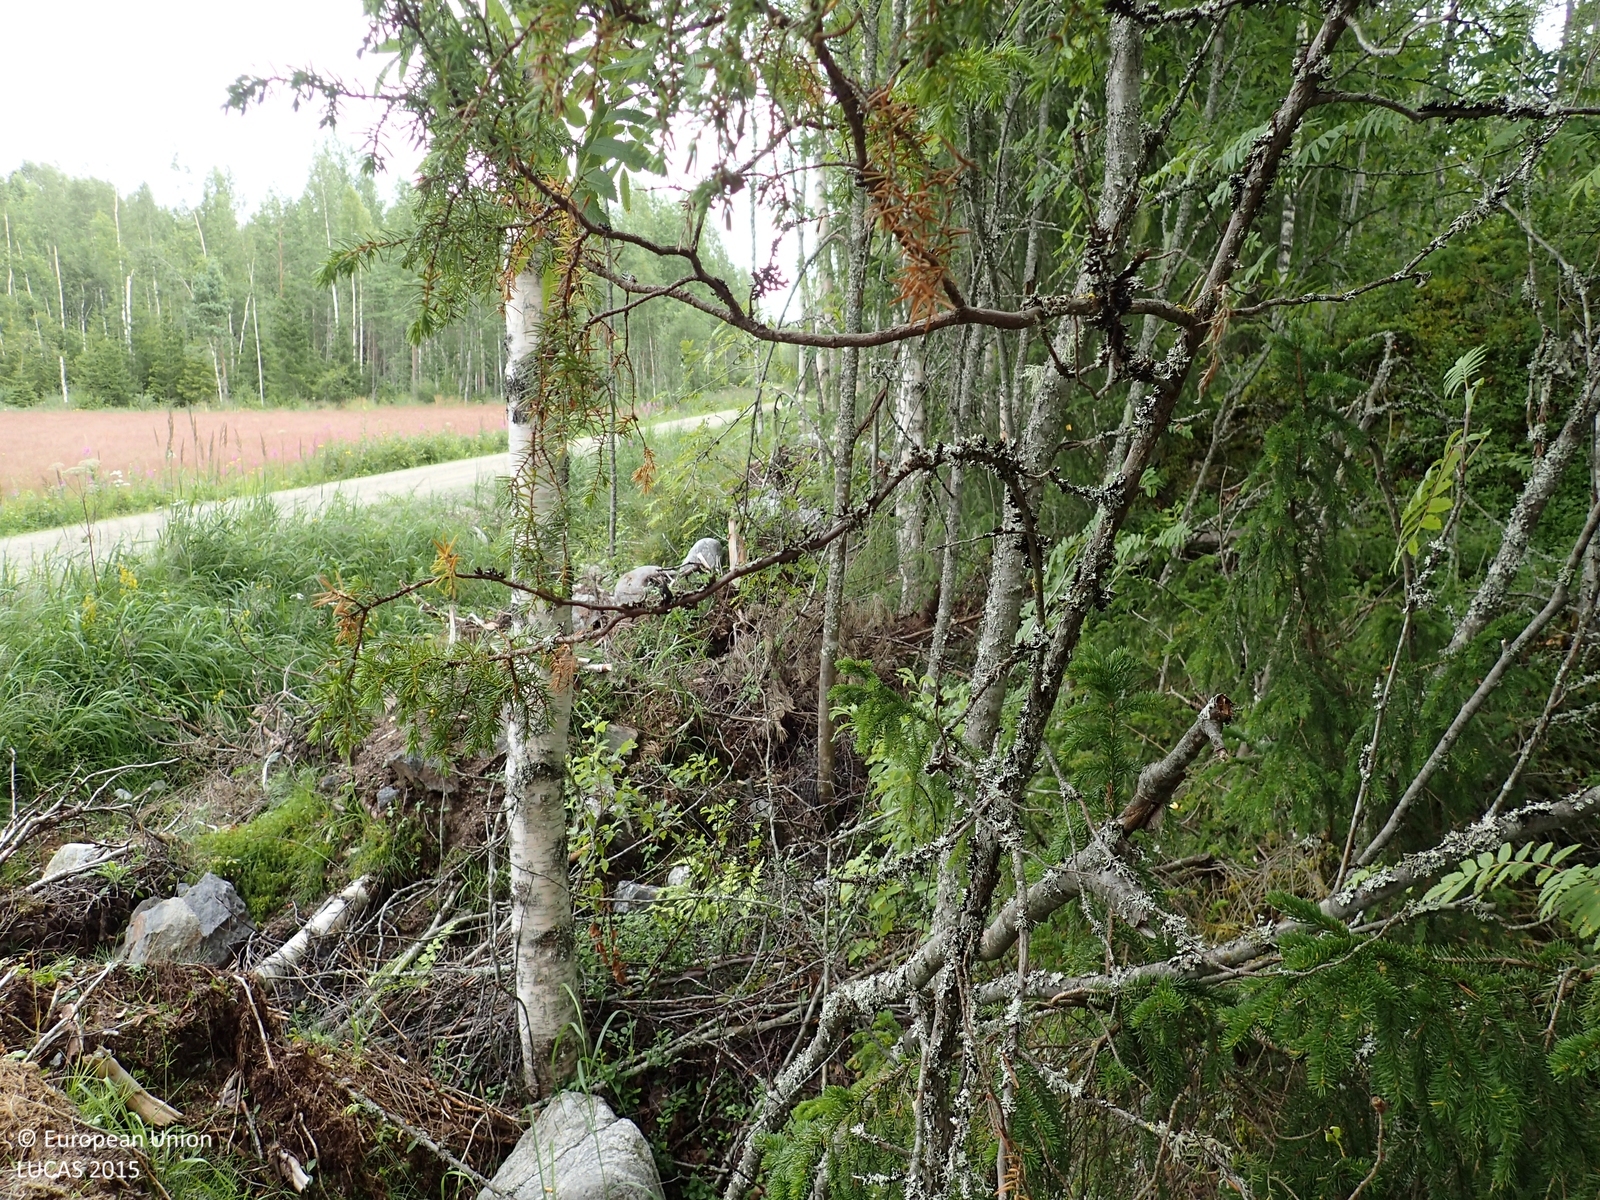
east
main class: Woodland
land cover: Other mixed woodland
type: boreal forest
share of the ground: > 75 %
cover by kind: coniferous forest trees 55 %, broadleaved forest trees 20 %, shrubs 20 %, lichens and mosses 5 %
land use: Forestry
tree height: > 5 m
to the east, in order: Other mixed woodland; Ditches and canals; Grass margins; Paved roads, cycling and walking lanes; Grass margins; Ditches and canals; Spontaneously vegetated surfaces; Pine dominated mixed woodland; Ditches and canals; Spruce dominated mixed woodland
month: August
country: FI
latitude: 62.7959
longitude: 21.9080
